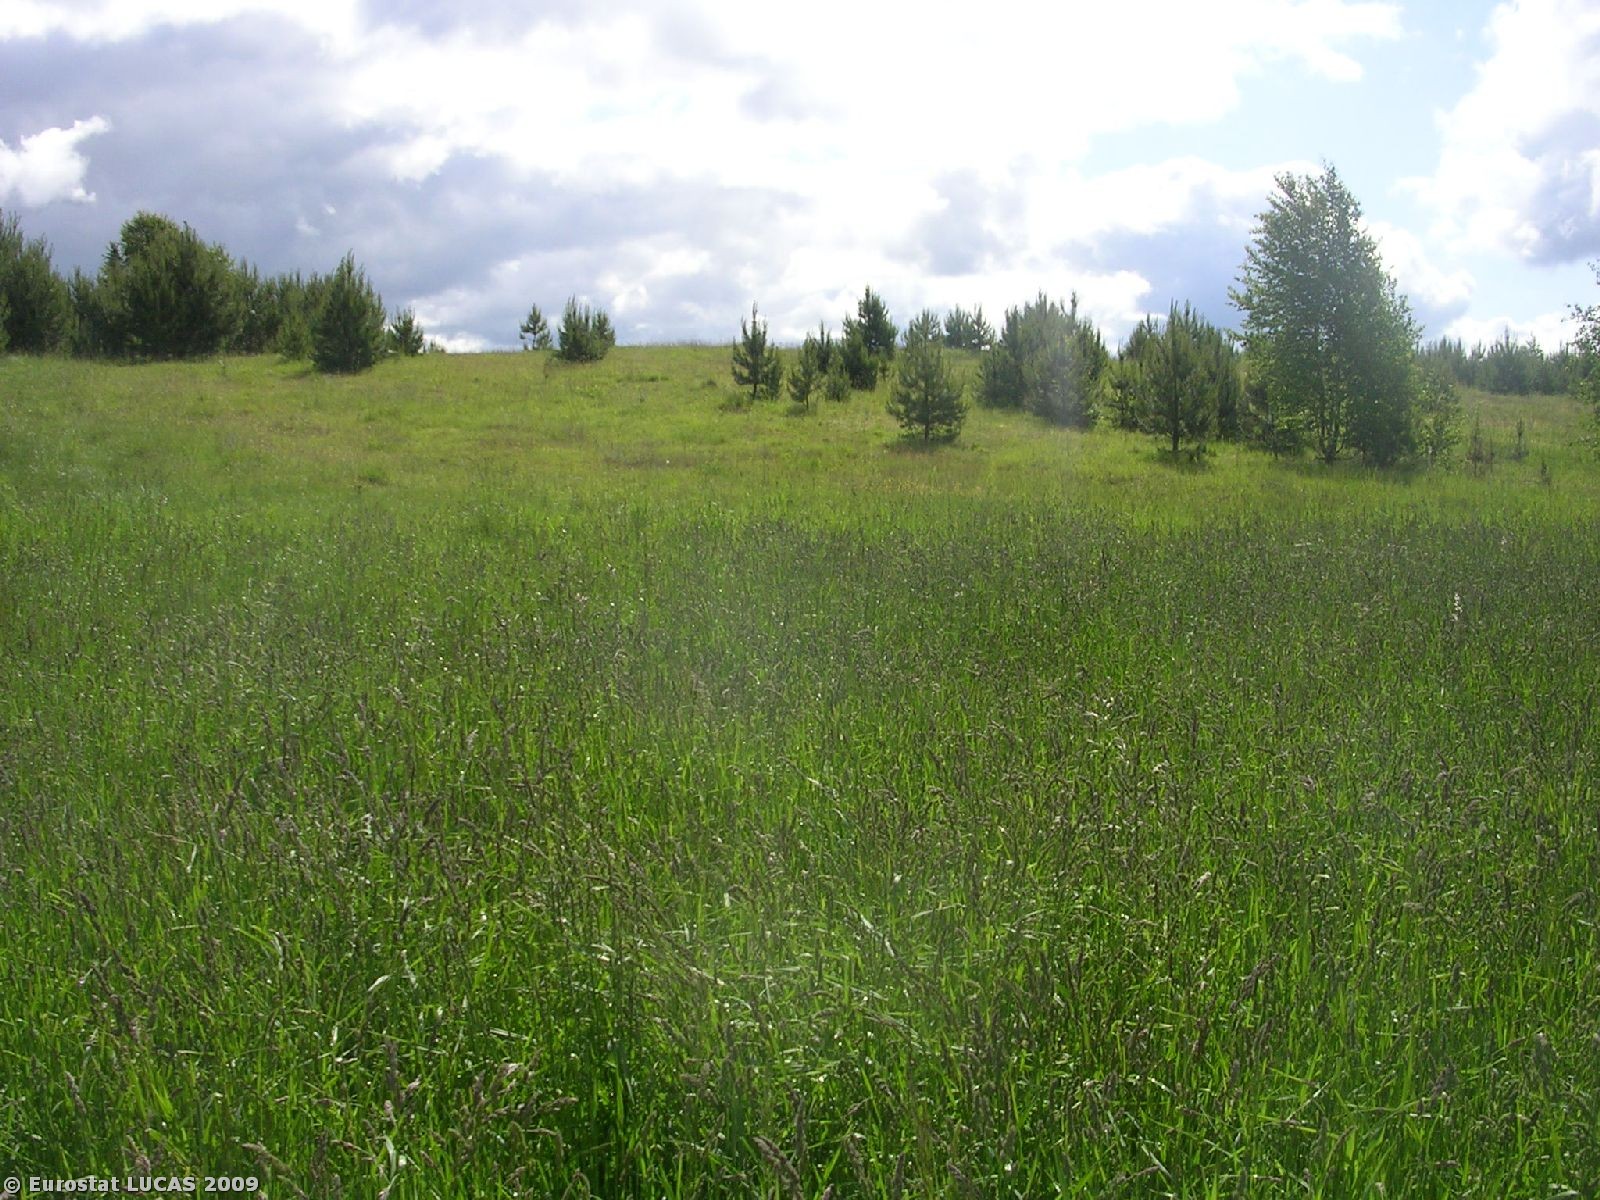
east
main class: Grassland
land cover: Grassland without tree/shrub cover
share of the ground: > 75 %
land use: Agriculture (excluding fallow land and kitchen gardens)
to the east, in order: Grassland without tree/shrub cover; Grassland with sparse tree/shrub cover; Grassland without tree/shrub cover
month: June
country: PL
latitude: 53.2623
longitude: 23.6544
